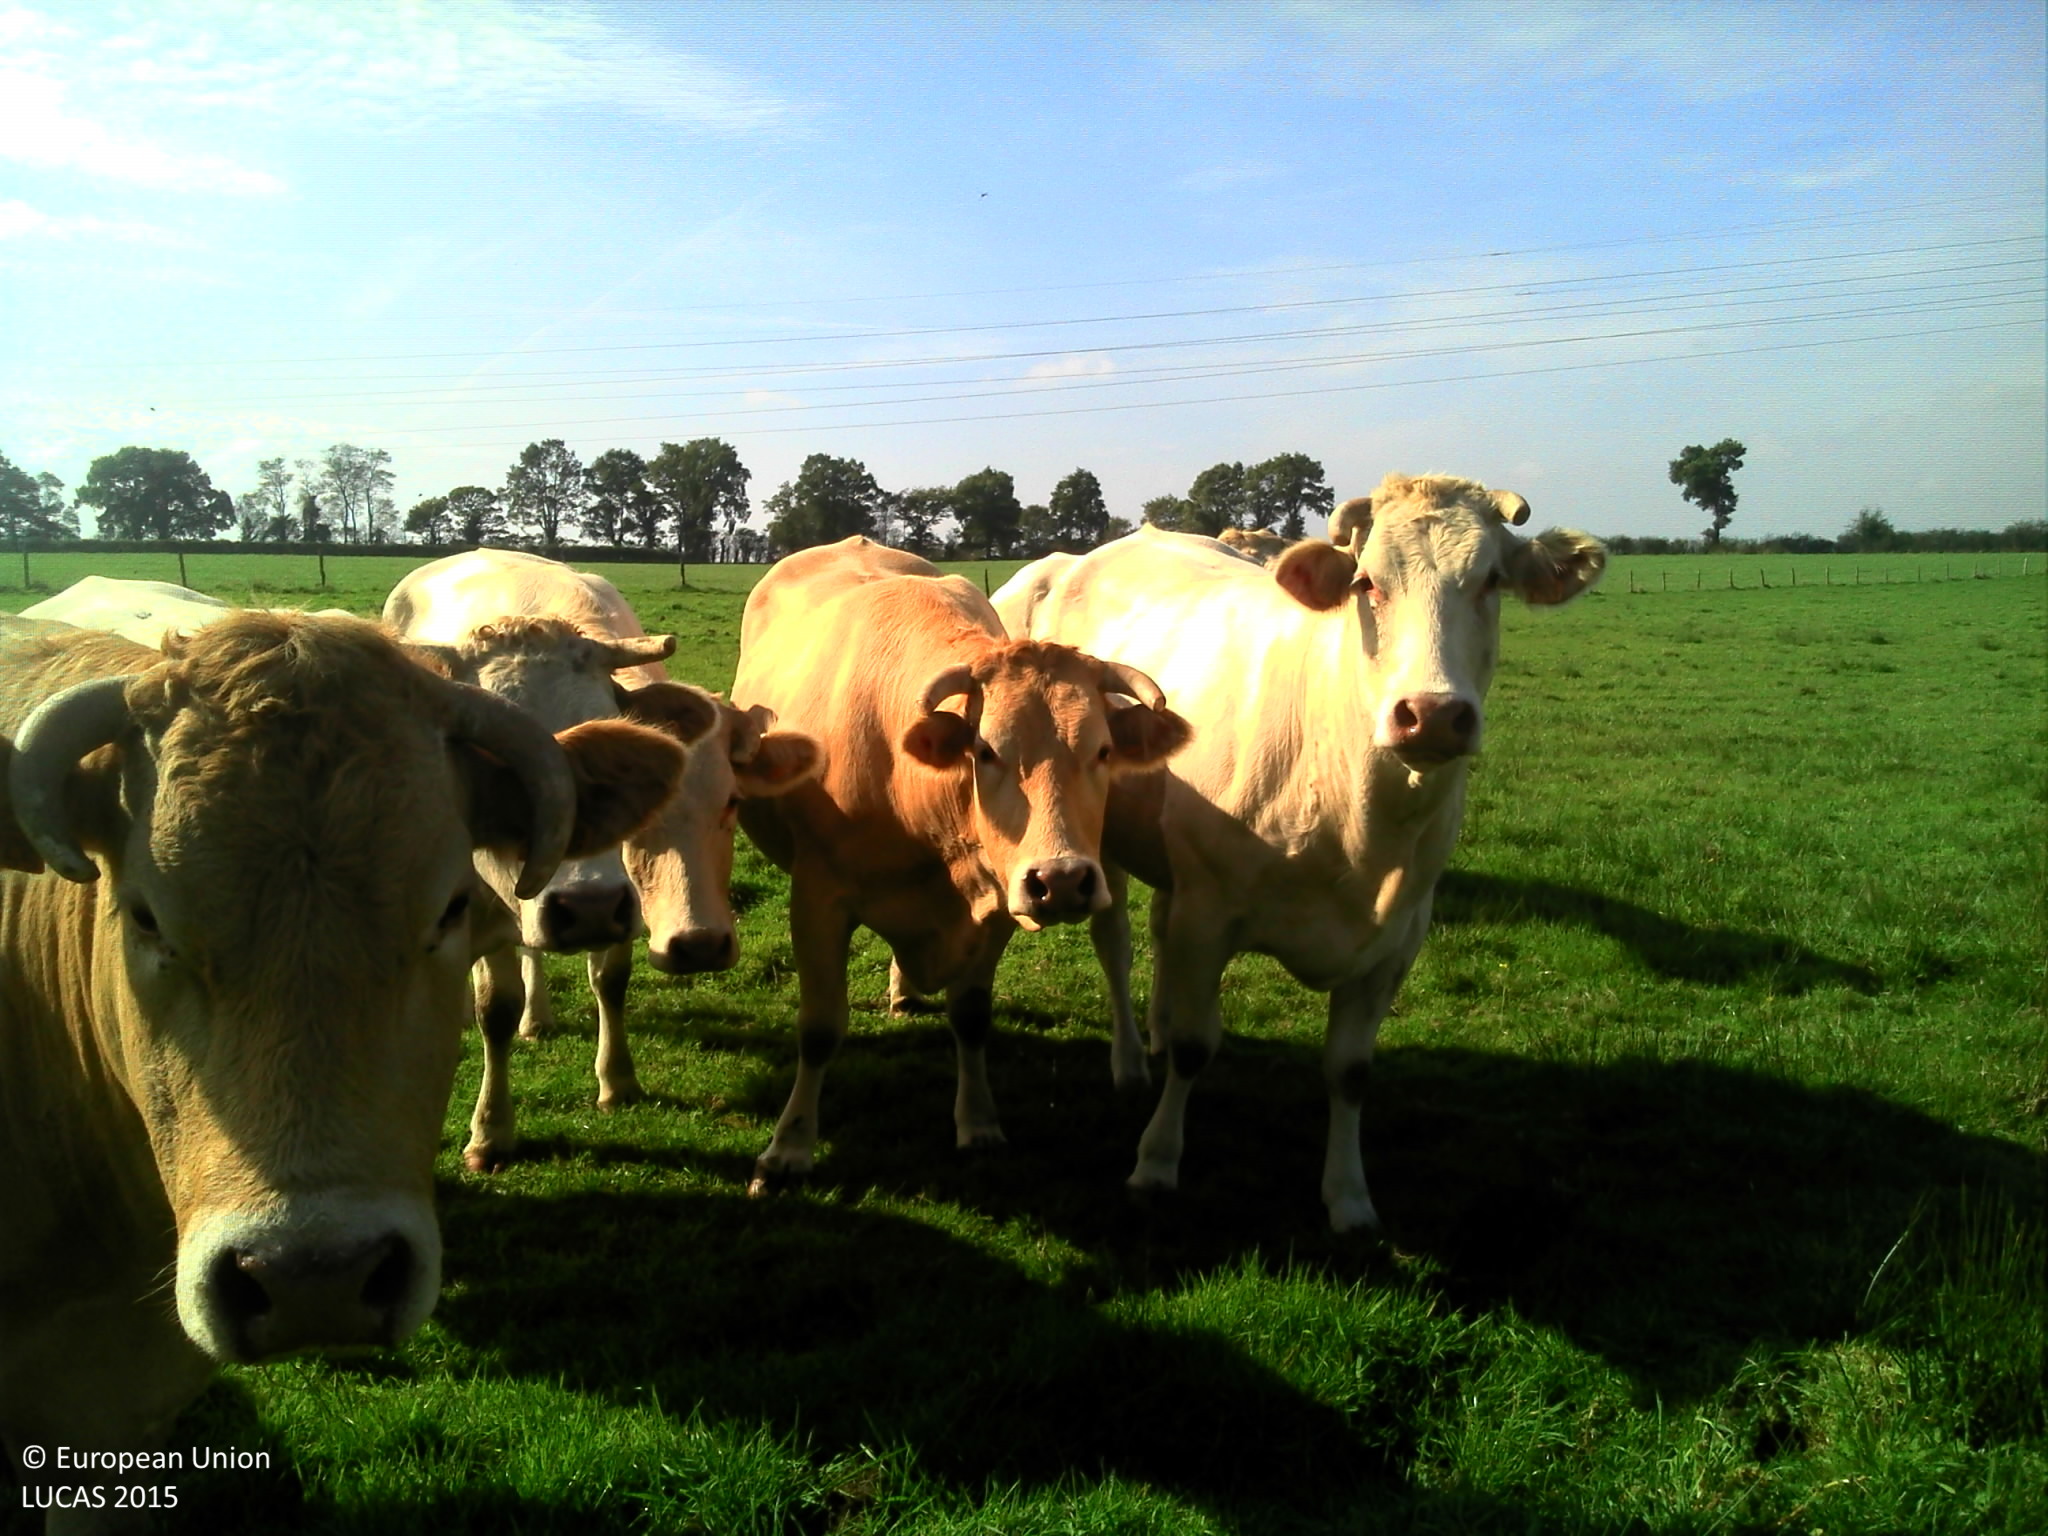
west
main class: Grassland
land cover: Grassland without tree/shrub cover
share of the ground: > 75 %
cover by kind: herbaceous plants 100 %
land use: Agriculture (excluding fallow land and kitchen gardens)
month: October
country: FR
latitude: 47.0973
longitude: -0.9297
